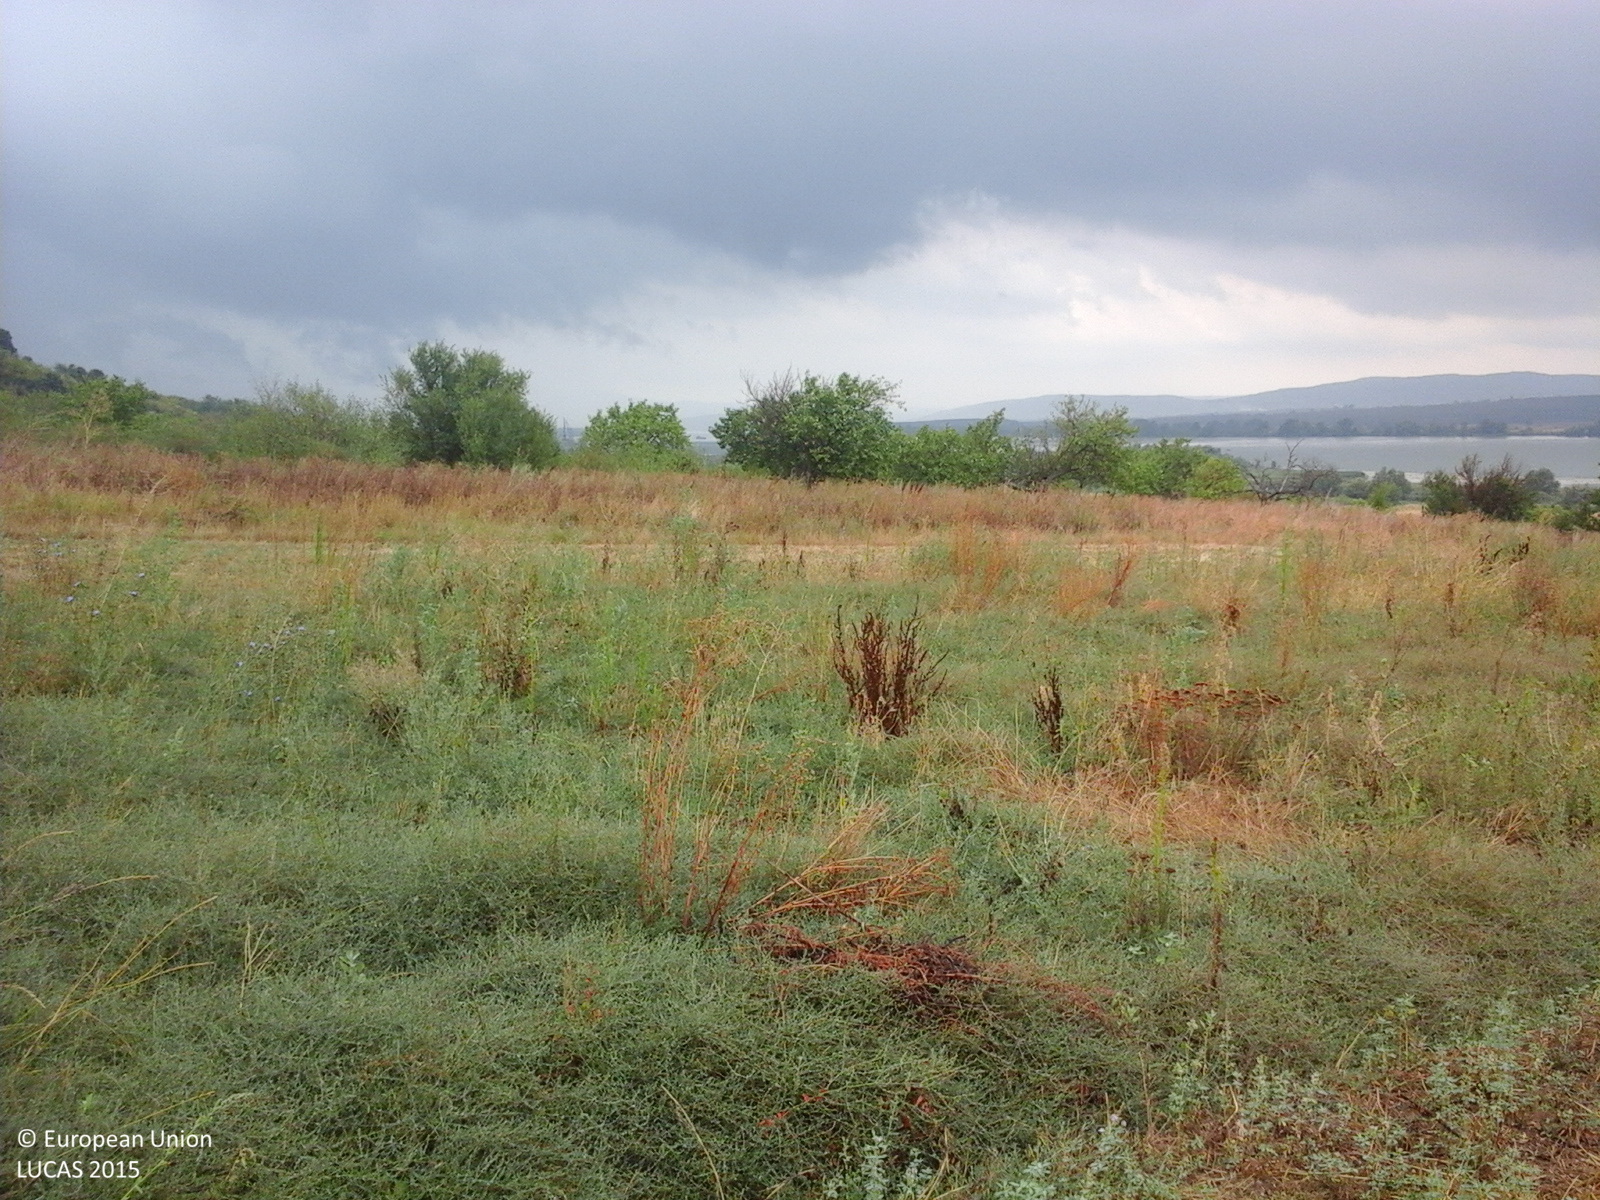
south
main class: Cropland
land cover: Lucerne
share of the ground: > 75 %
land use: Agriculture (excluding fallow land and kitchen gardens)
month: August
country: RO
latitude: 44.7521
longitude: 21.6120
